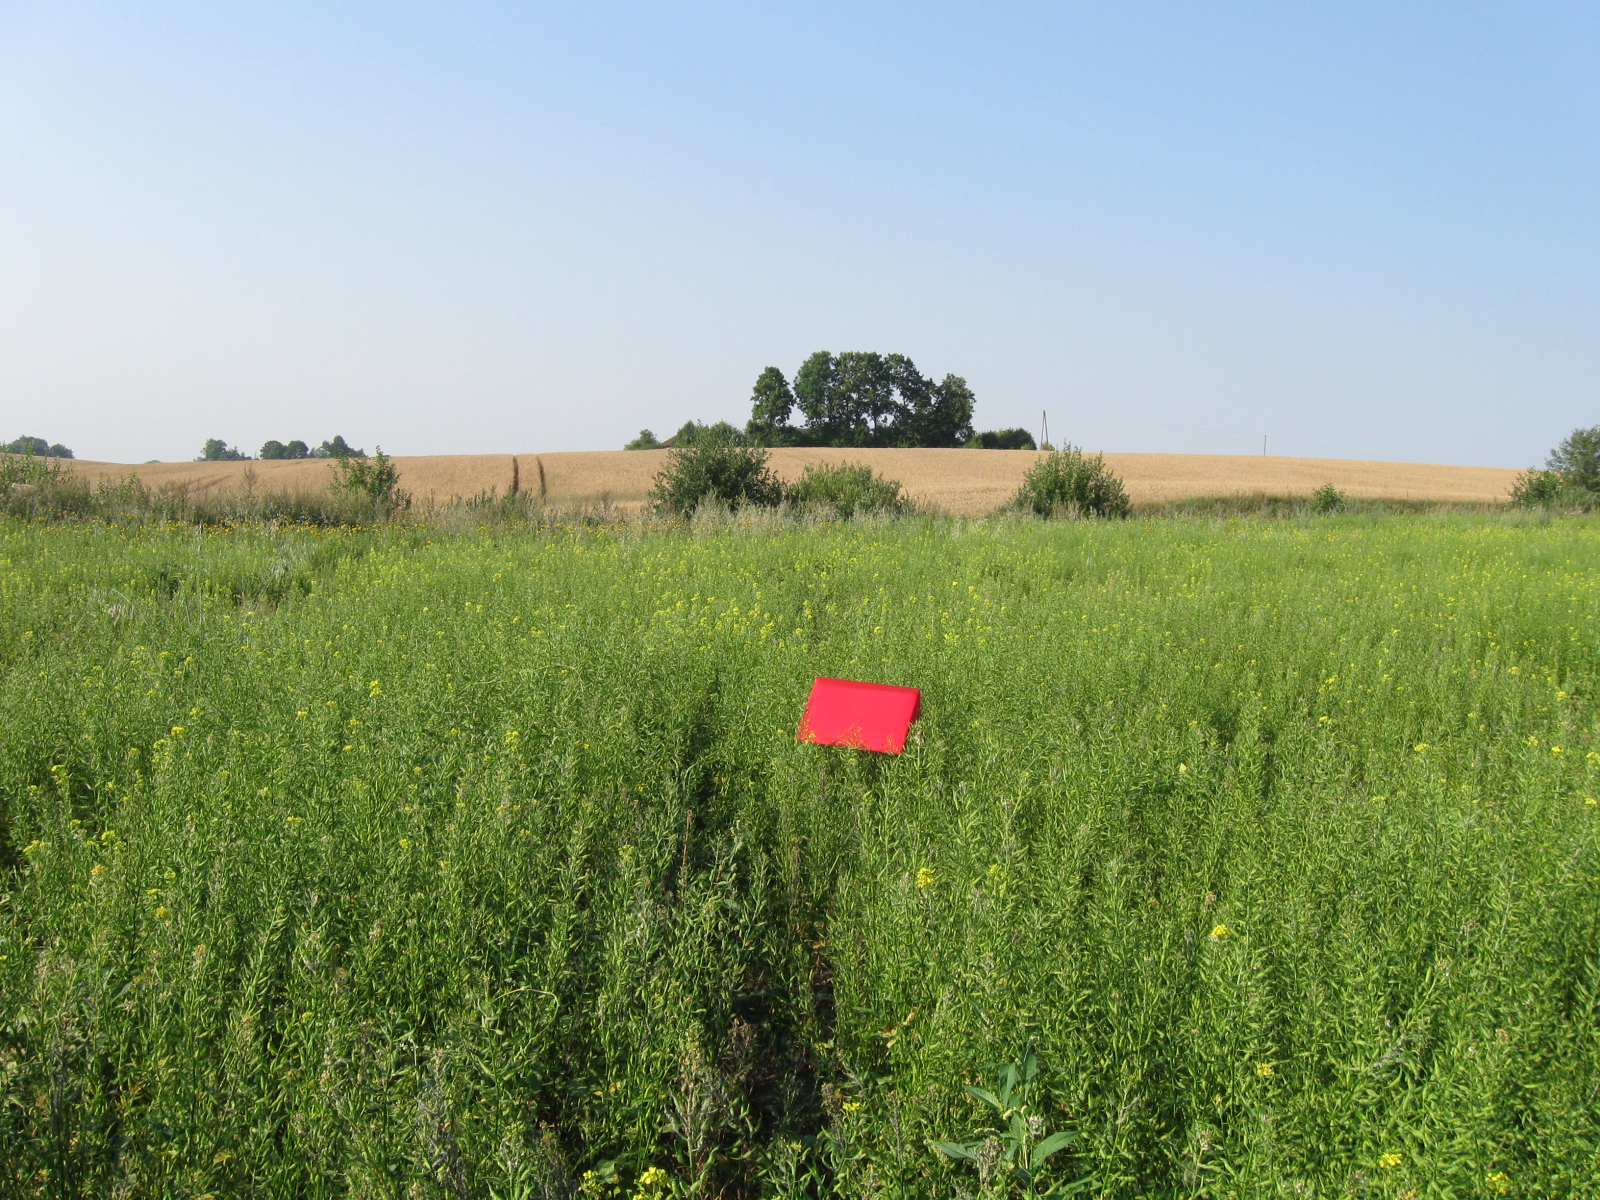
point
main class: Cropland
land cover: Other fibre and oleaginous crops
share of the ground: > 75 %
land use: Agriculture (excluding fallow land and kitchen gardens)
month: August
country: LT
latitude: 54.3702
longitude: 23.2065
